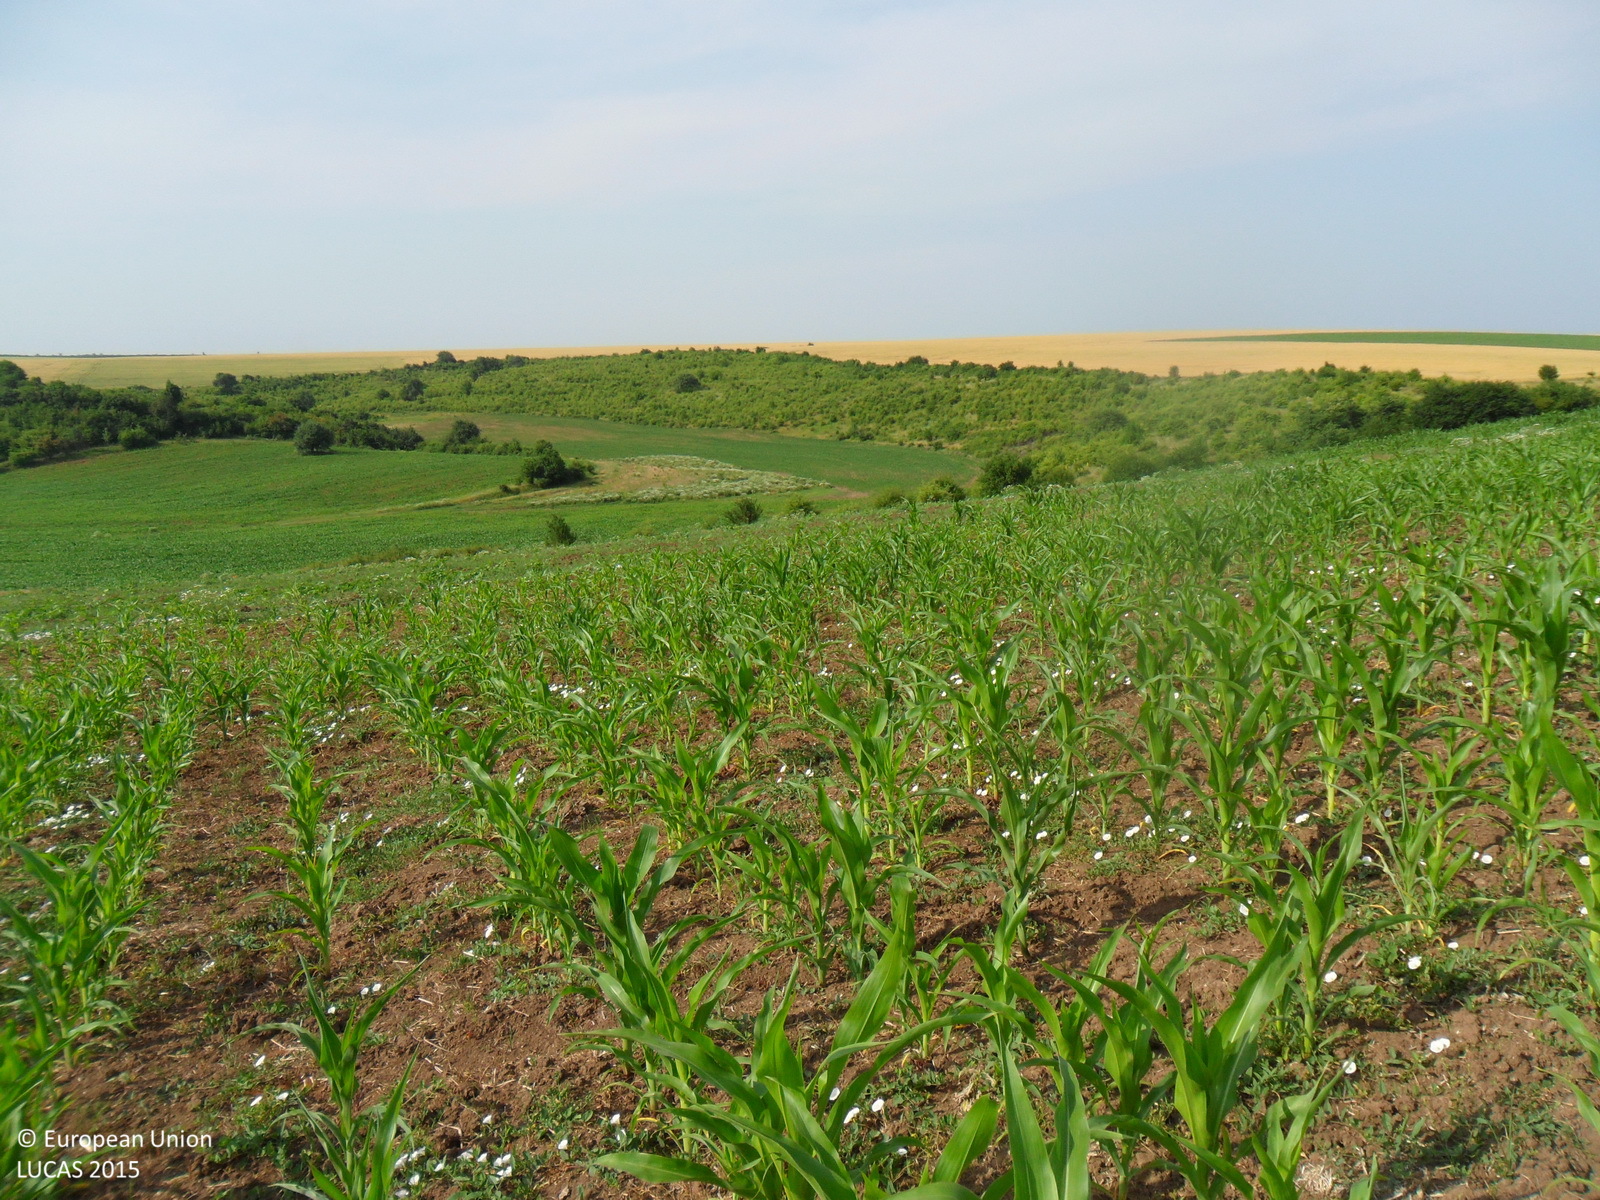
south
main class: Cropland
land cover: Maize
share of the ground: 50 - 75 %
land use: Agriculture (excluding fallow land and kitchen gardens)
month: June
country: BG
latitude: 43.6741
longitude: 26.8728
